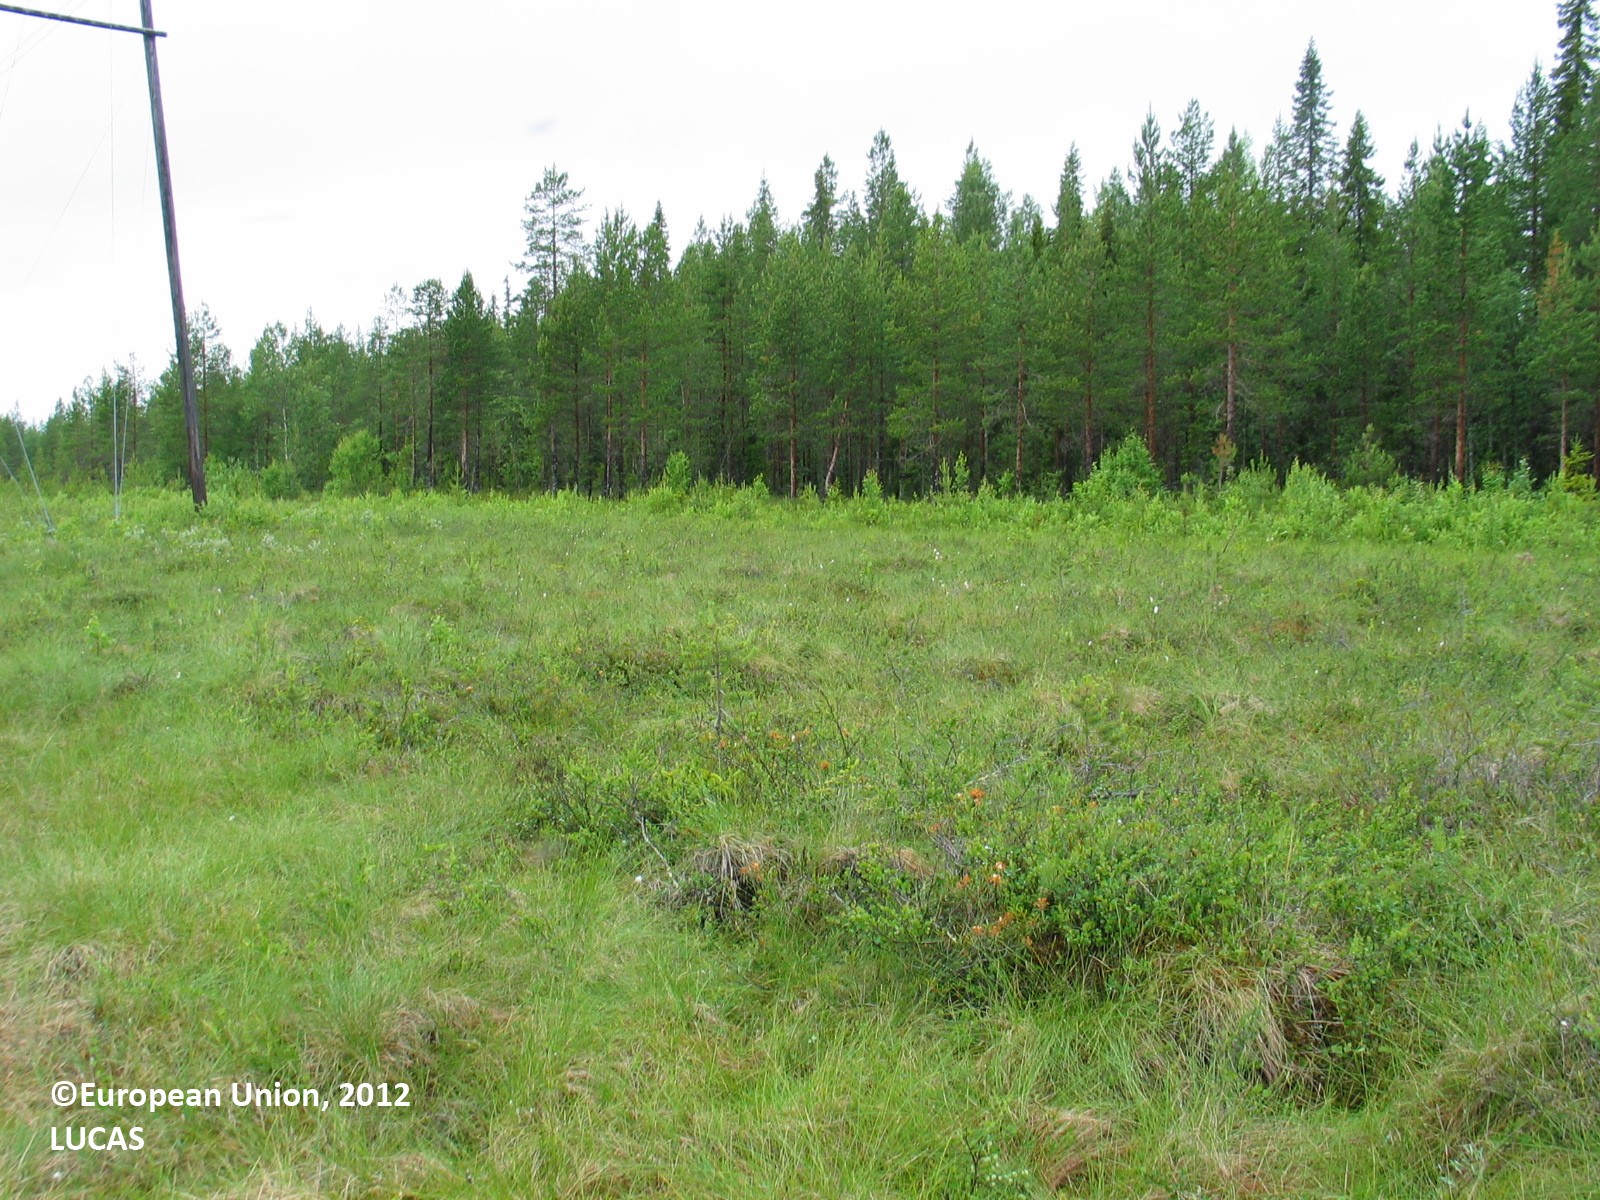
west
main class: Grassland
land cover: Grassland without tree/shrub cover
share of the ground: > 75 %
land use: Energy production
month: July
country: FI
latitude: 66.0444
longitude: 25.0025
